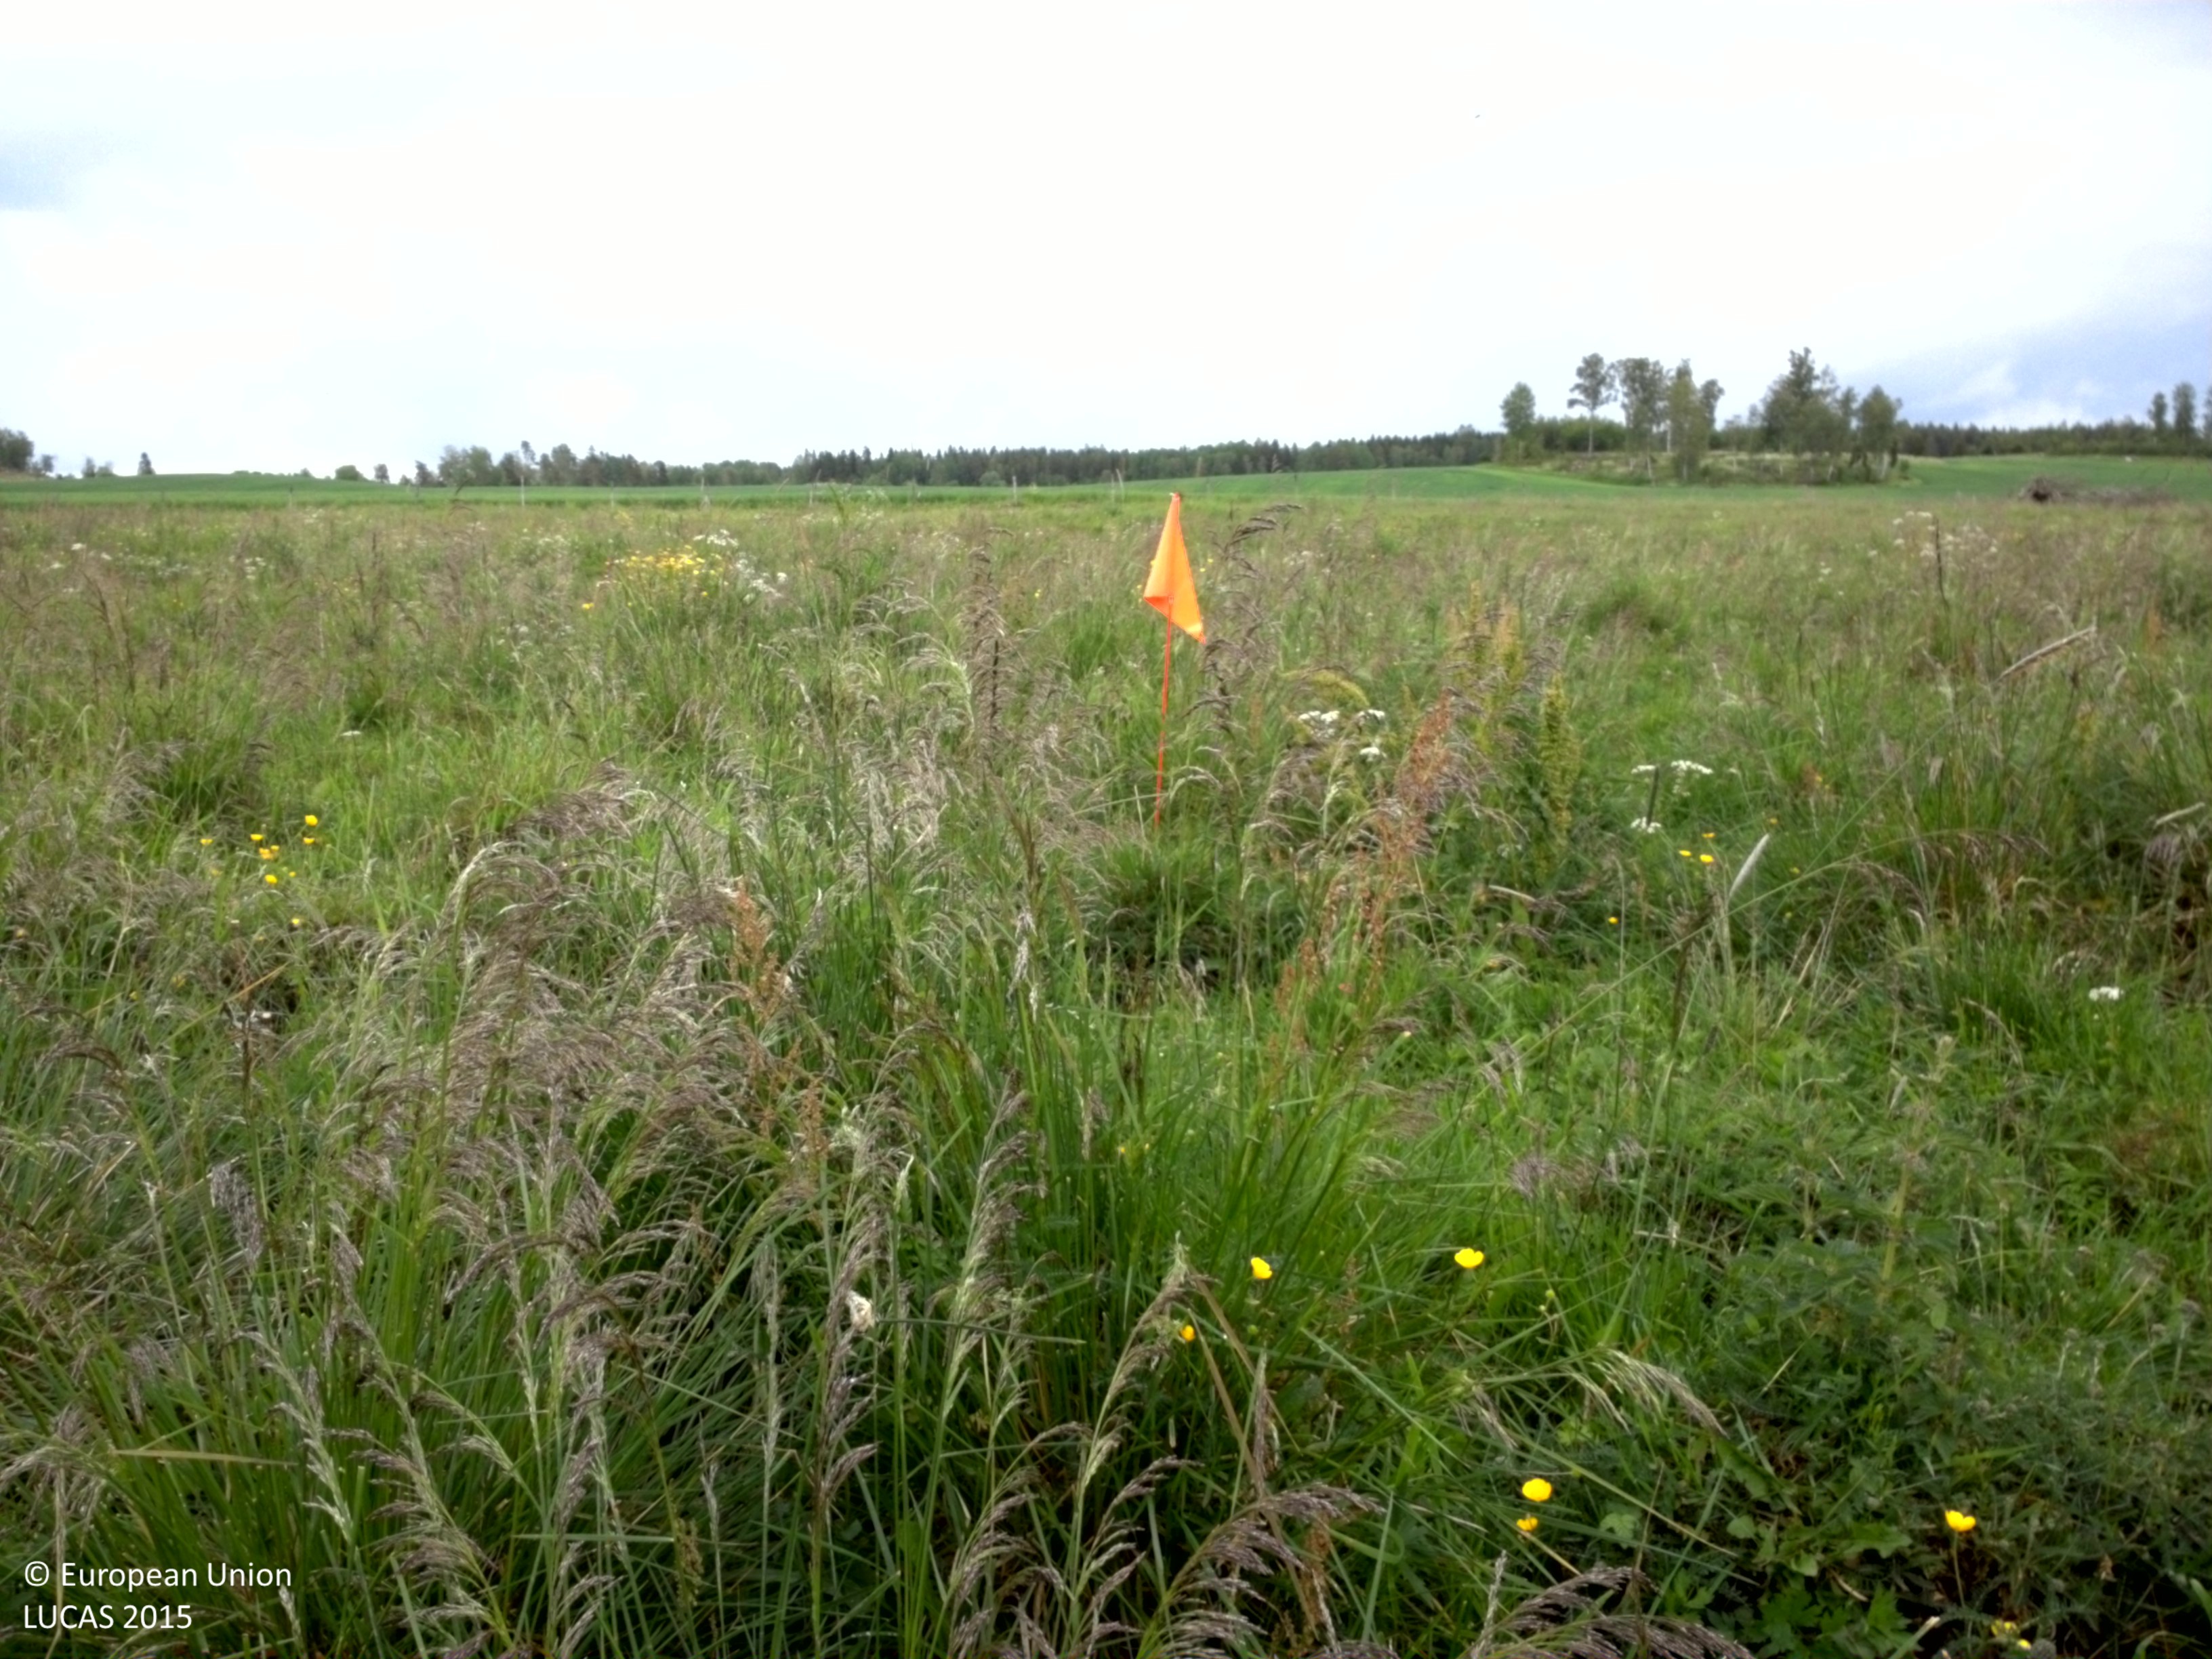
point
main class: Grassland
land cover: Grassland without tree/shrub cover
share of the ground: > 75 %
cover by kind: herbaceous plants 100 %
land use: Agriculture (excluding fallow land and kitchen gardens)
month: June
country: SE
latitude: 59.8617
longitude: 17.0096
